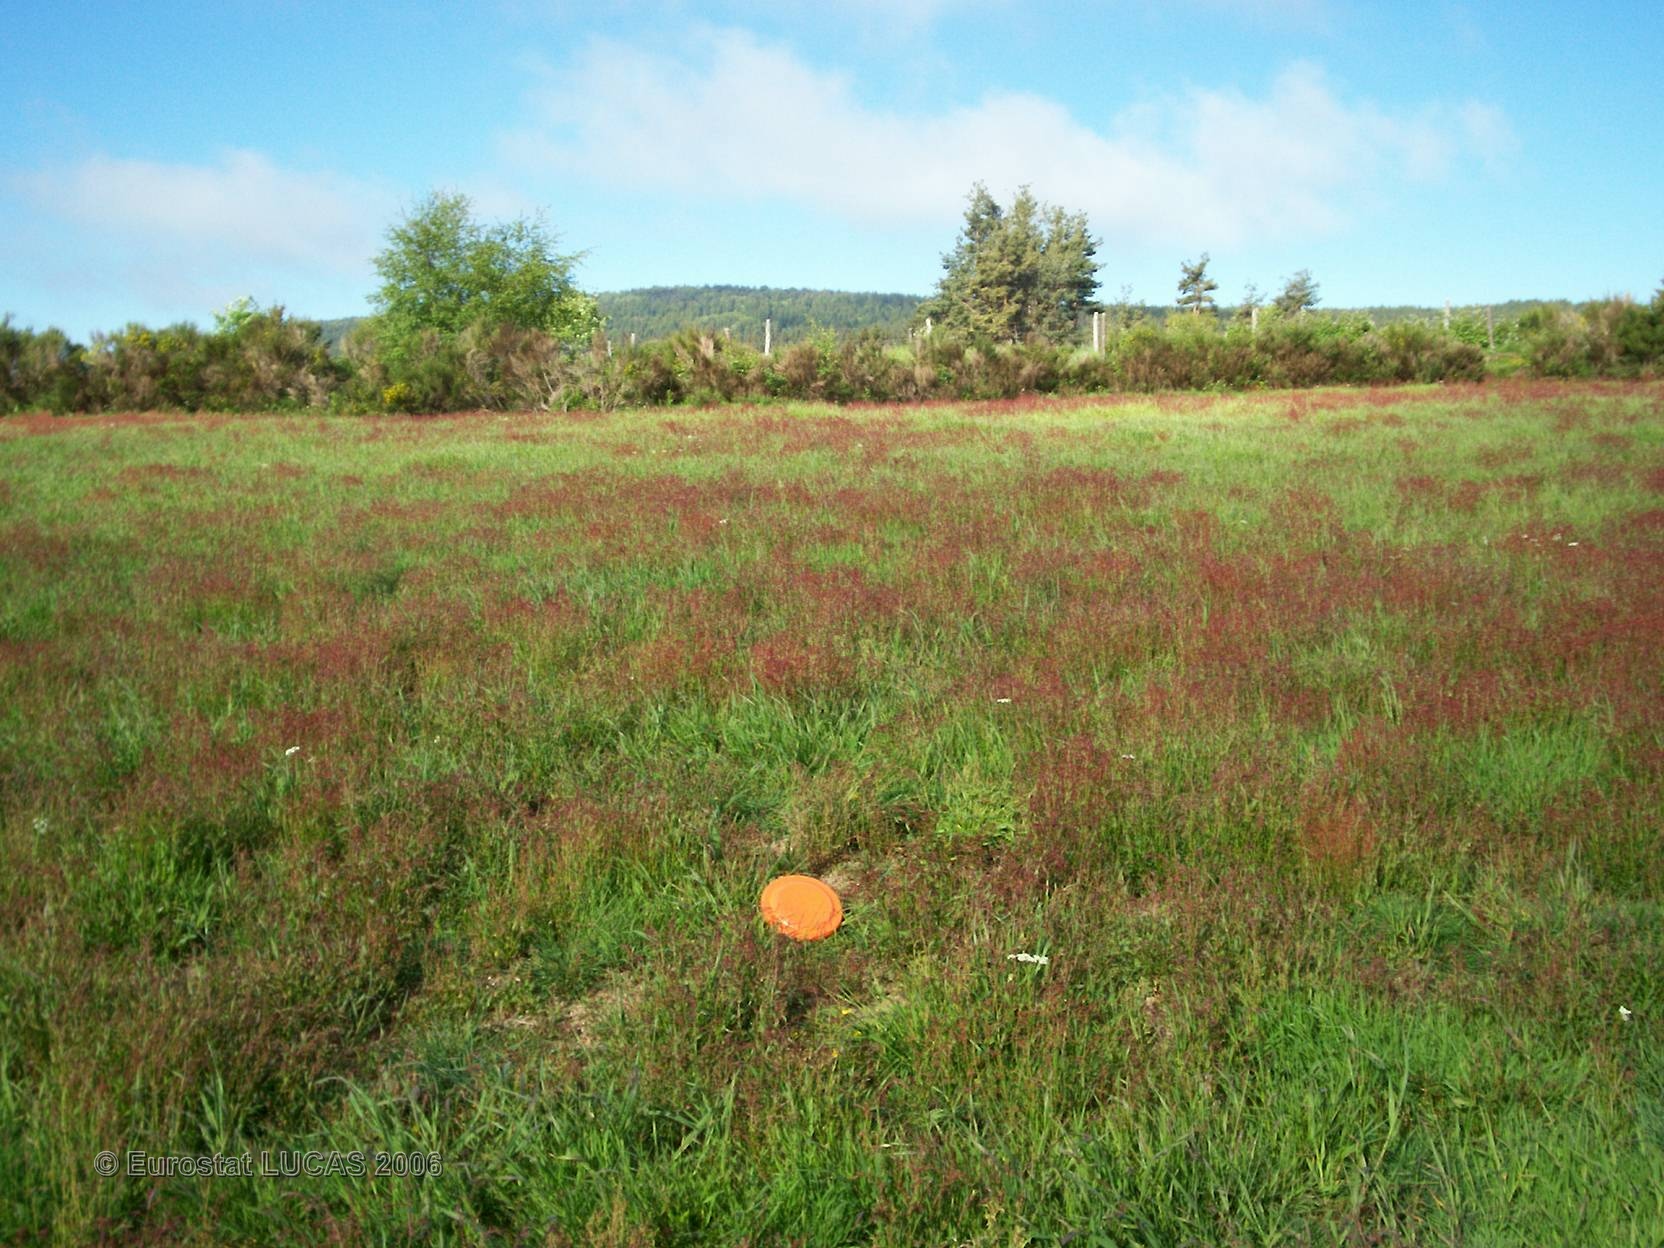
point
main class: Grassland
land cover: Grassland without tree/shrub cover
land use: Agriculture (excluding fallow land and kitchen gardens)
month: June
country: FR
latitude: 44.9526
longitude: 3.3741
